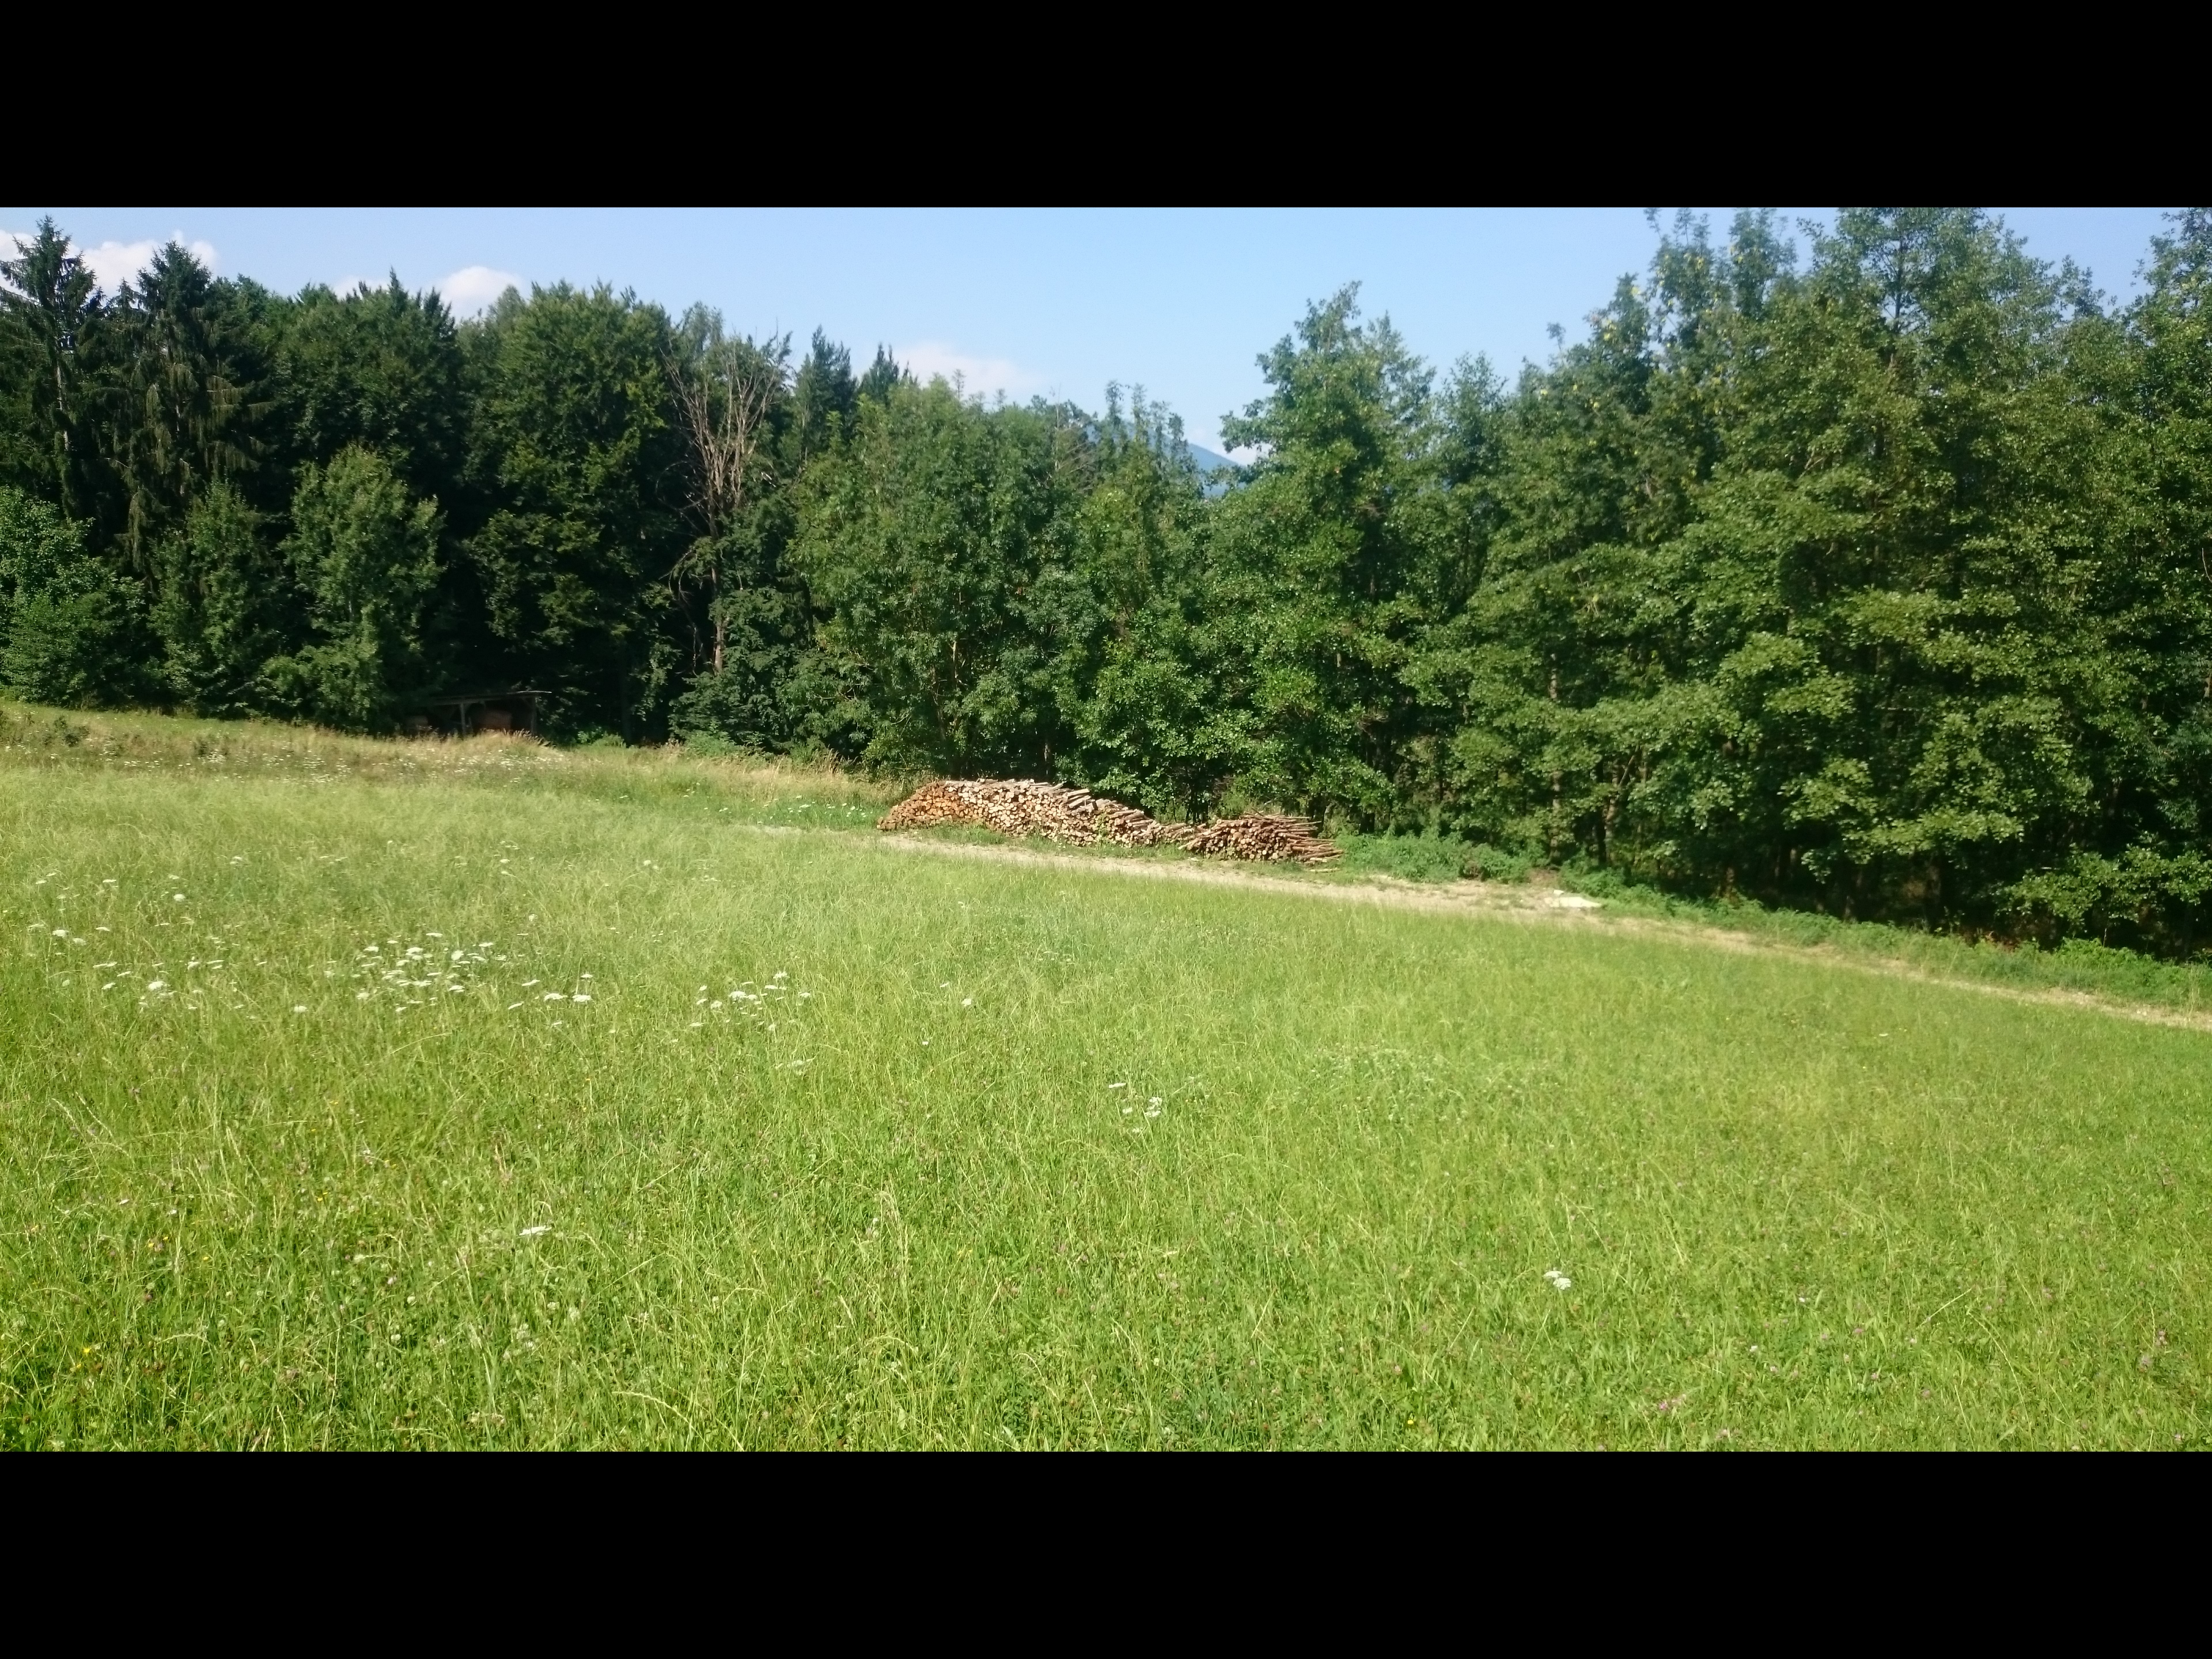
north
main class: Grassland
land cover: Grassland without tree/shrub cover
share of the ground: > 75 %
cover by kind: herbaceous plants 95 %, unconsolidated bare surface 5 %
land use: Agriculture (excluding fallow land and kitchen gardens)
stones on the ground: < 10 %
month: July
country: AT
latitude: 47.1967
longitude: 15.6103
